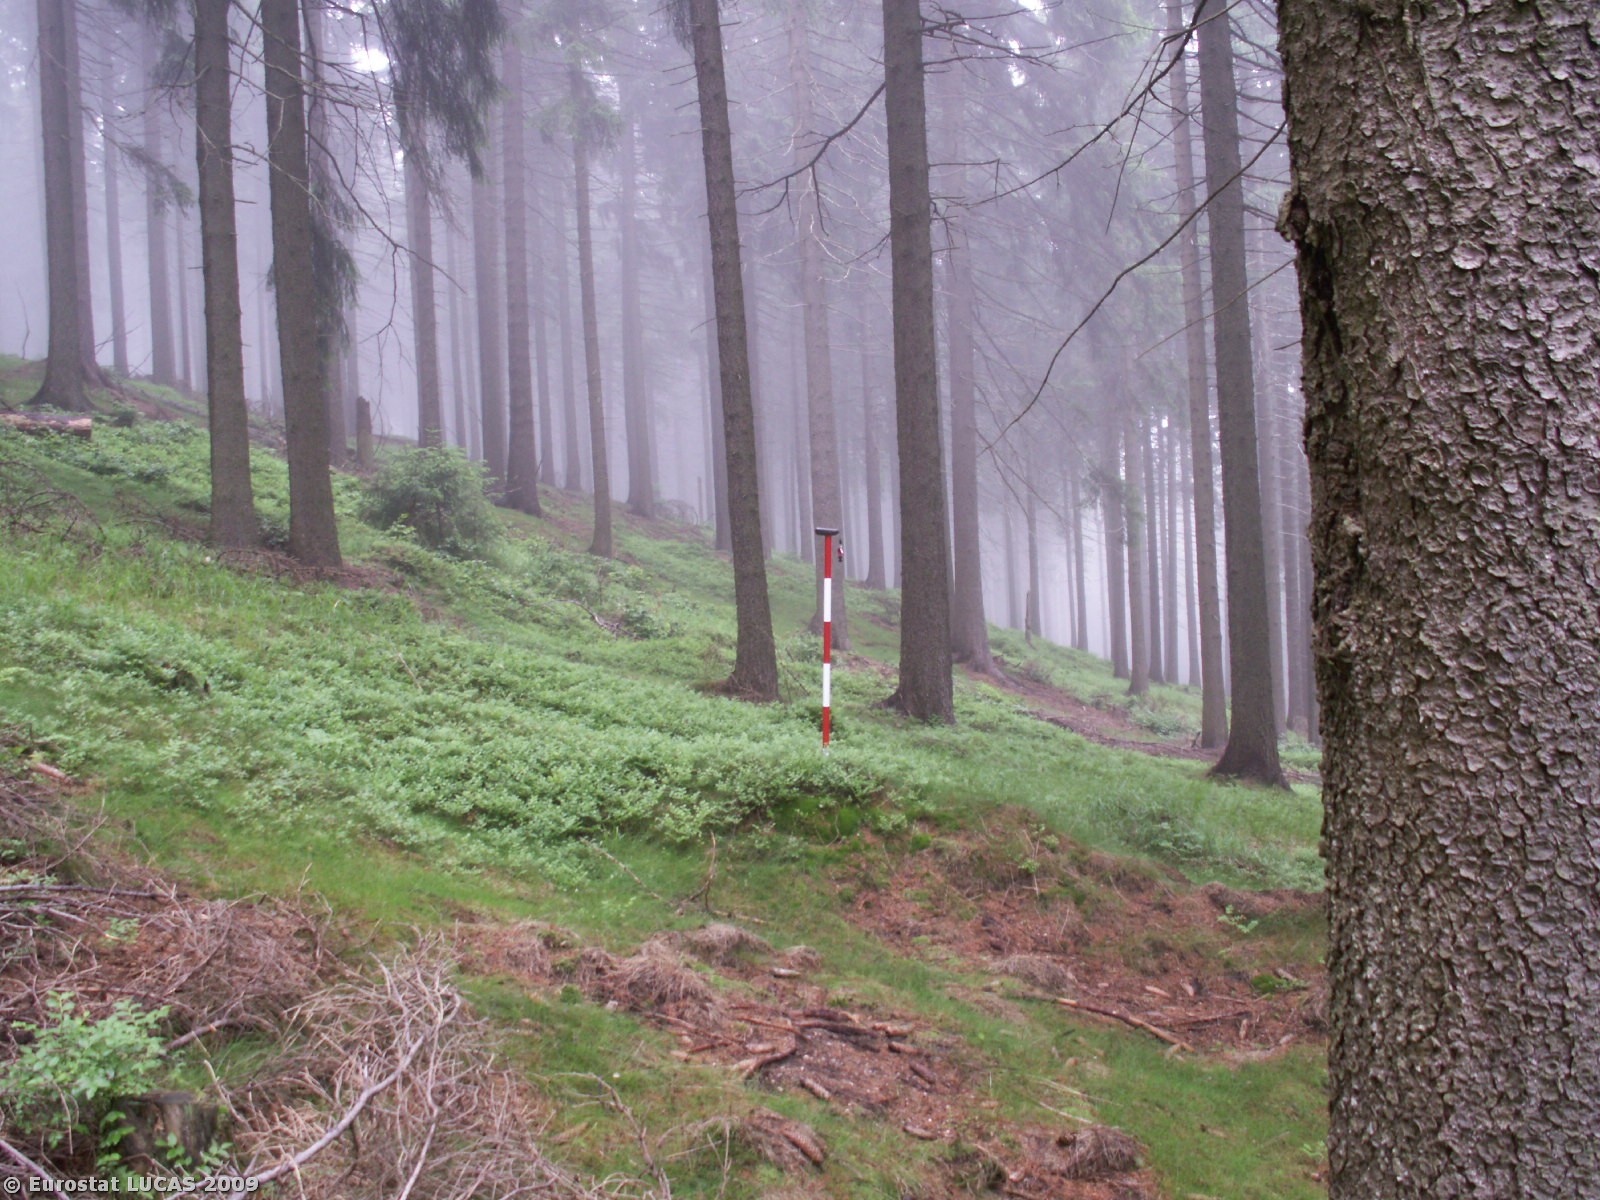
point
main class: Woodland
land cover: Coniferous woodland
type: hemiboreal forest and nemoral coniferous forest and mixed broadleaved-coniferous forest
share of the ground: > 75 %
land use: Forestry
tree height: > 5 m
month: June
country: CZ
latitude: 50.3672
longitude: 12.7413
